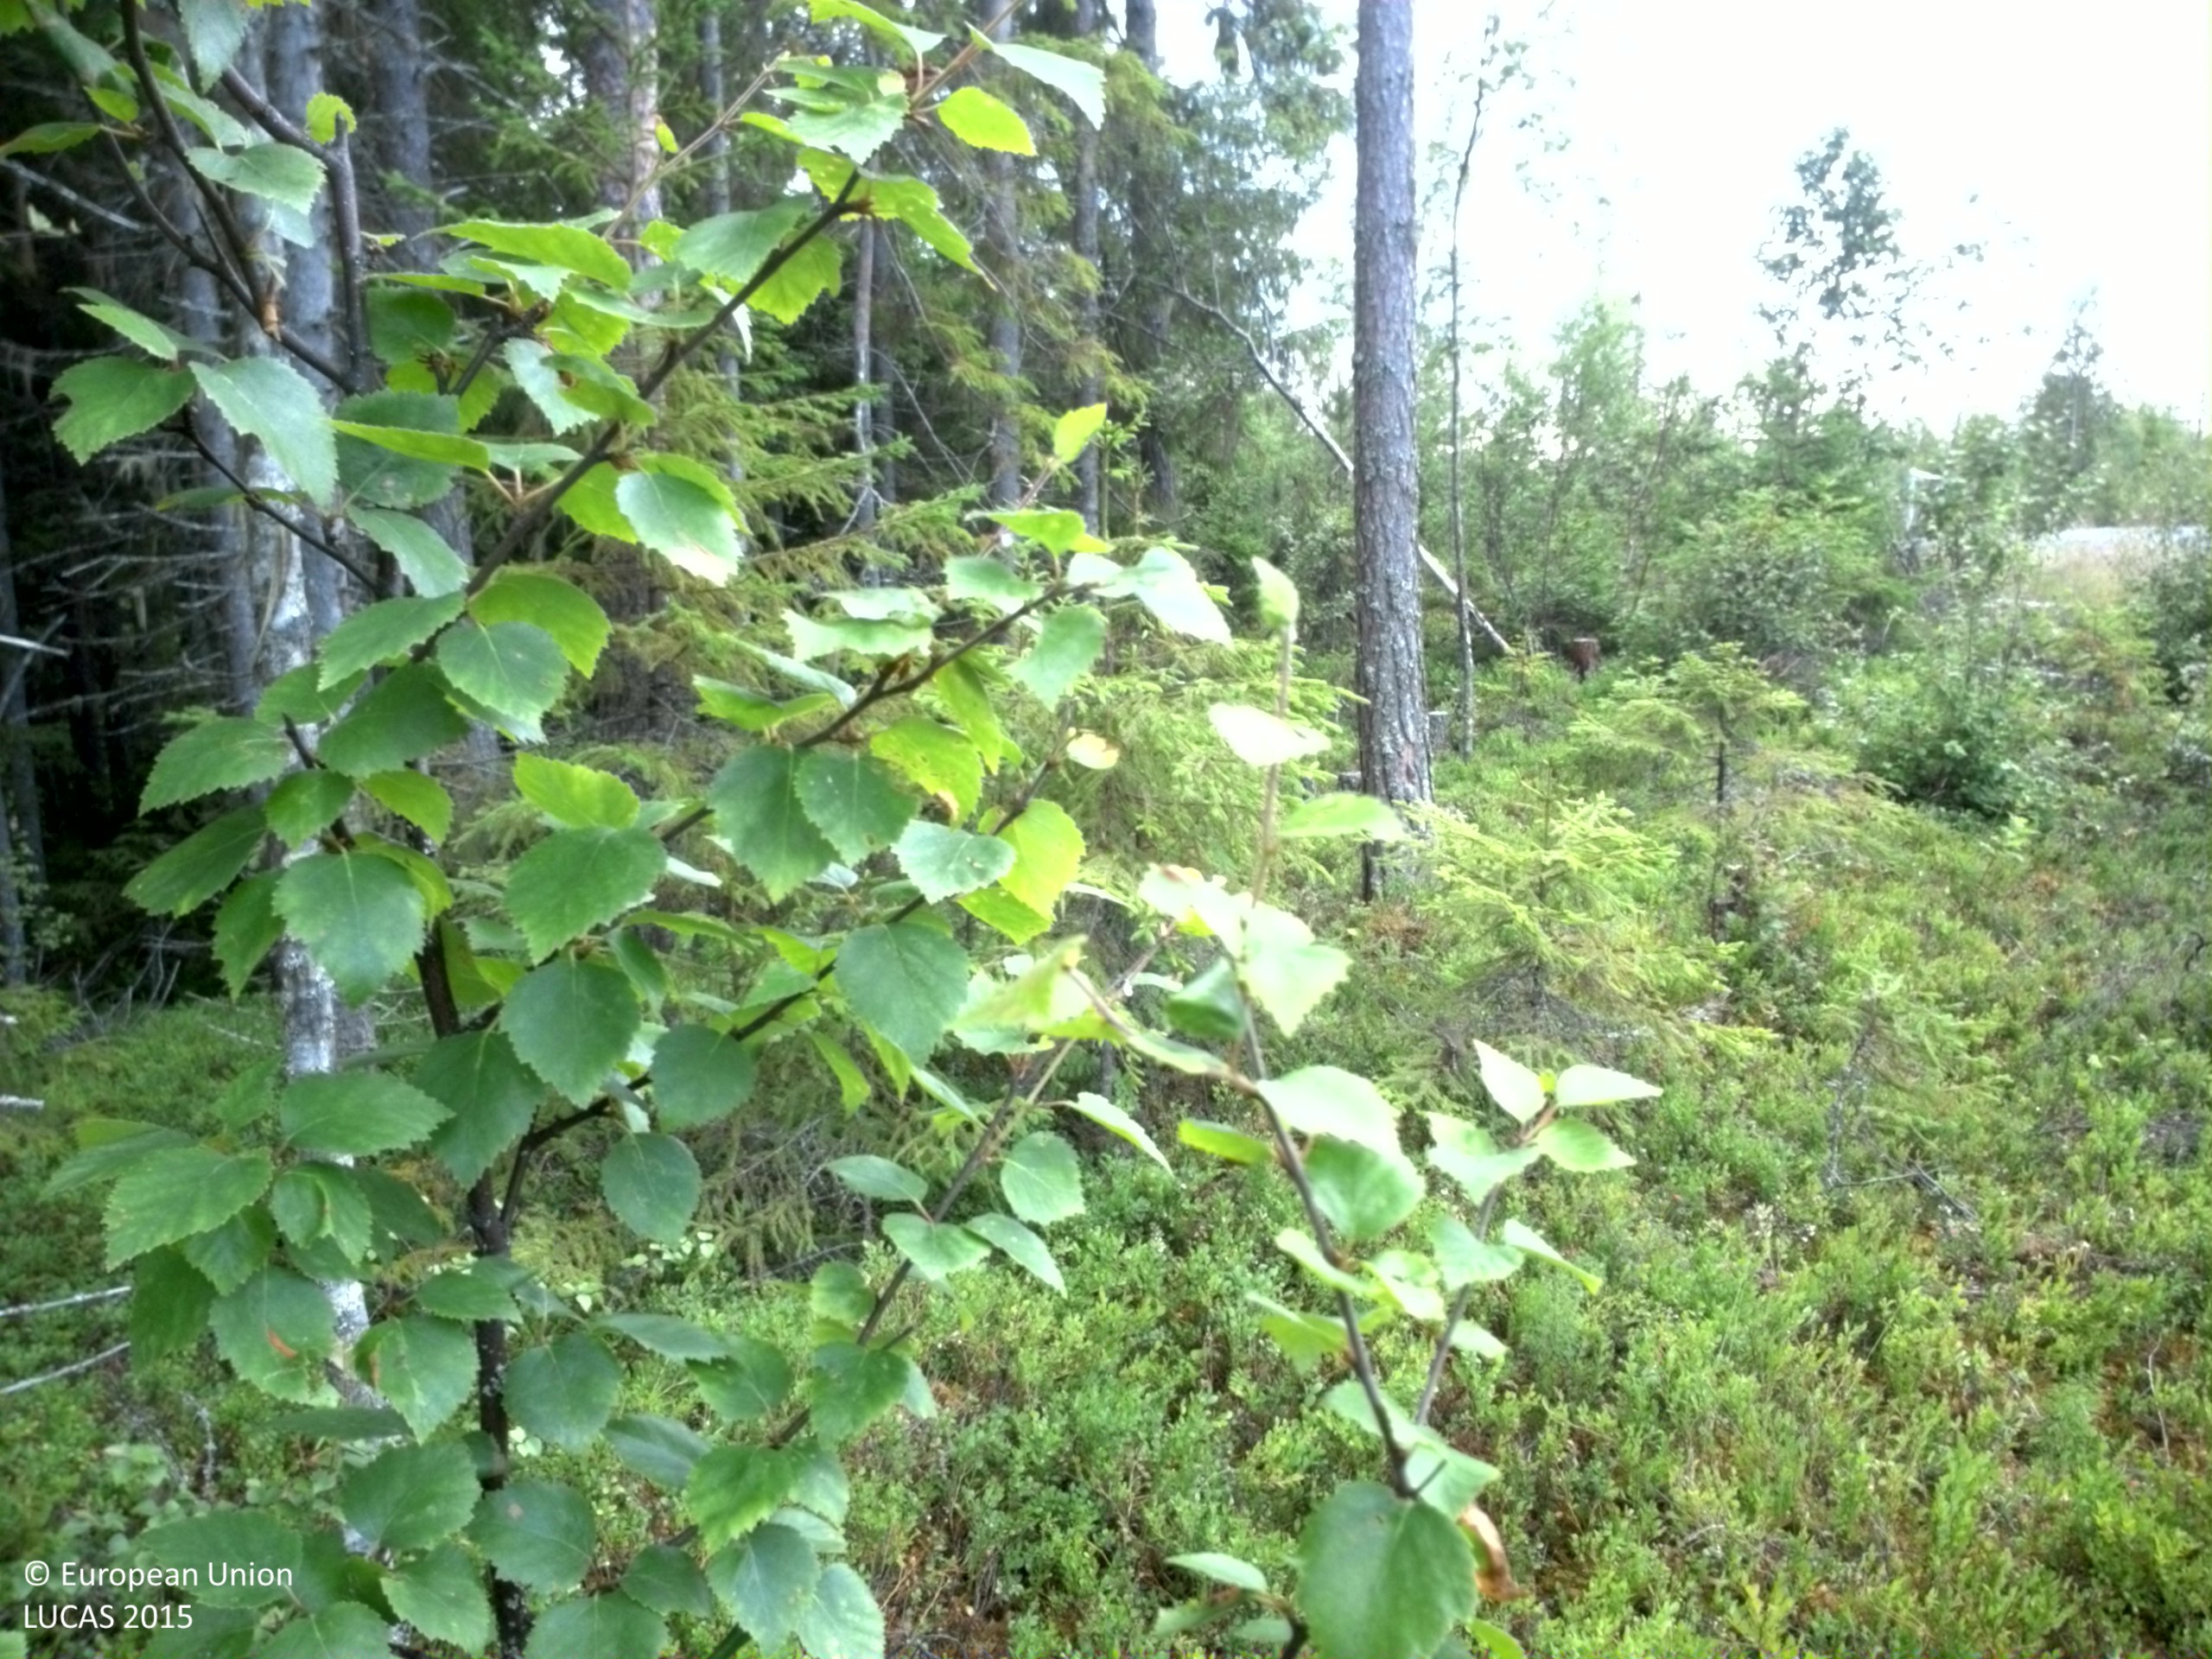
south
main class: Woodland
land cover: Spruce dominated coniferous woodland
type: boreal forest
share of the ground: 50 - 75 %
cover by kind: coniferous forest trees 65 %, shrubs 30 %, broadleaved forest trees 5 %
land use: Forestry
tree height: < 5 m
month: July
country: SE
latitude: 63.1766
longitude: 17.7033
